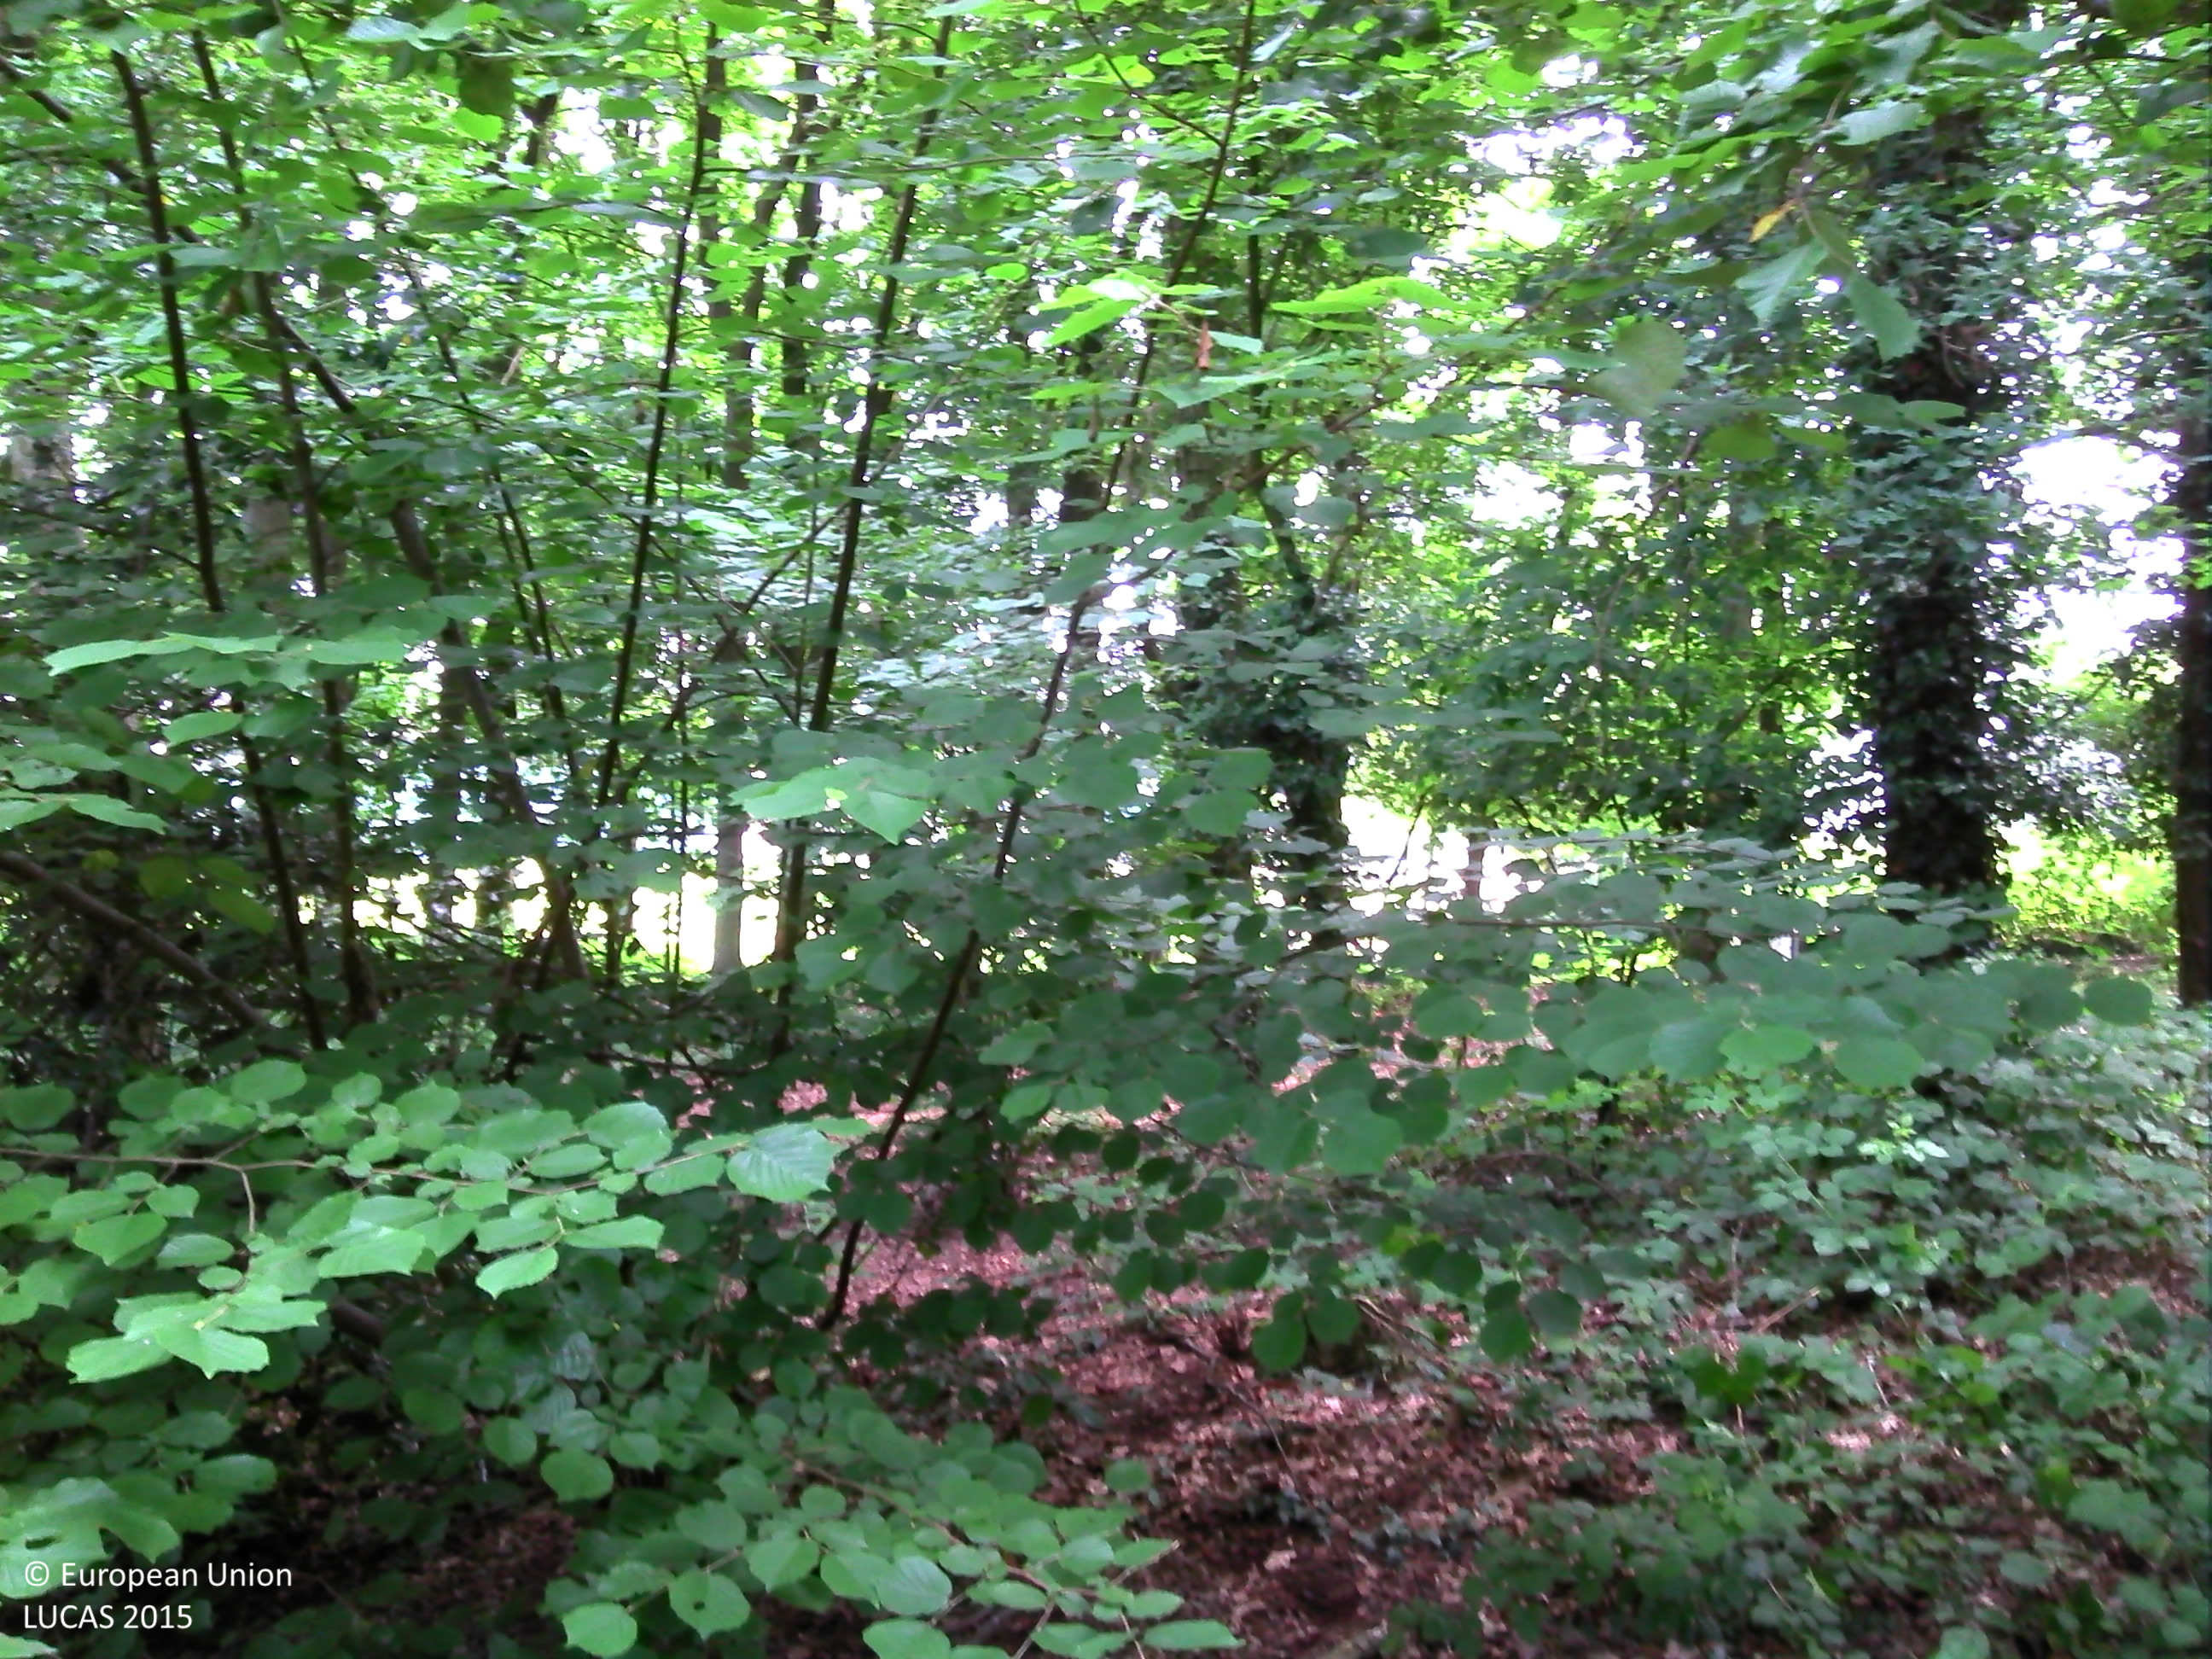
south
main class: Woodland
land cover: Pine dominated mixed woodland
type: exotic forest
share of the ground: > 75 %
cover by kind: coniferous forest trees 60 %, broadleaved forest trees 40 %
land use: Forestry
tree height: > 5 m
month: June
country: BE
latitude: 50.9310
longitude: 5.6872
